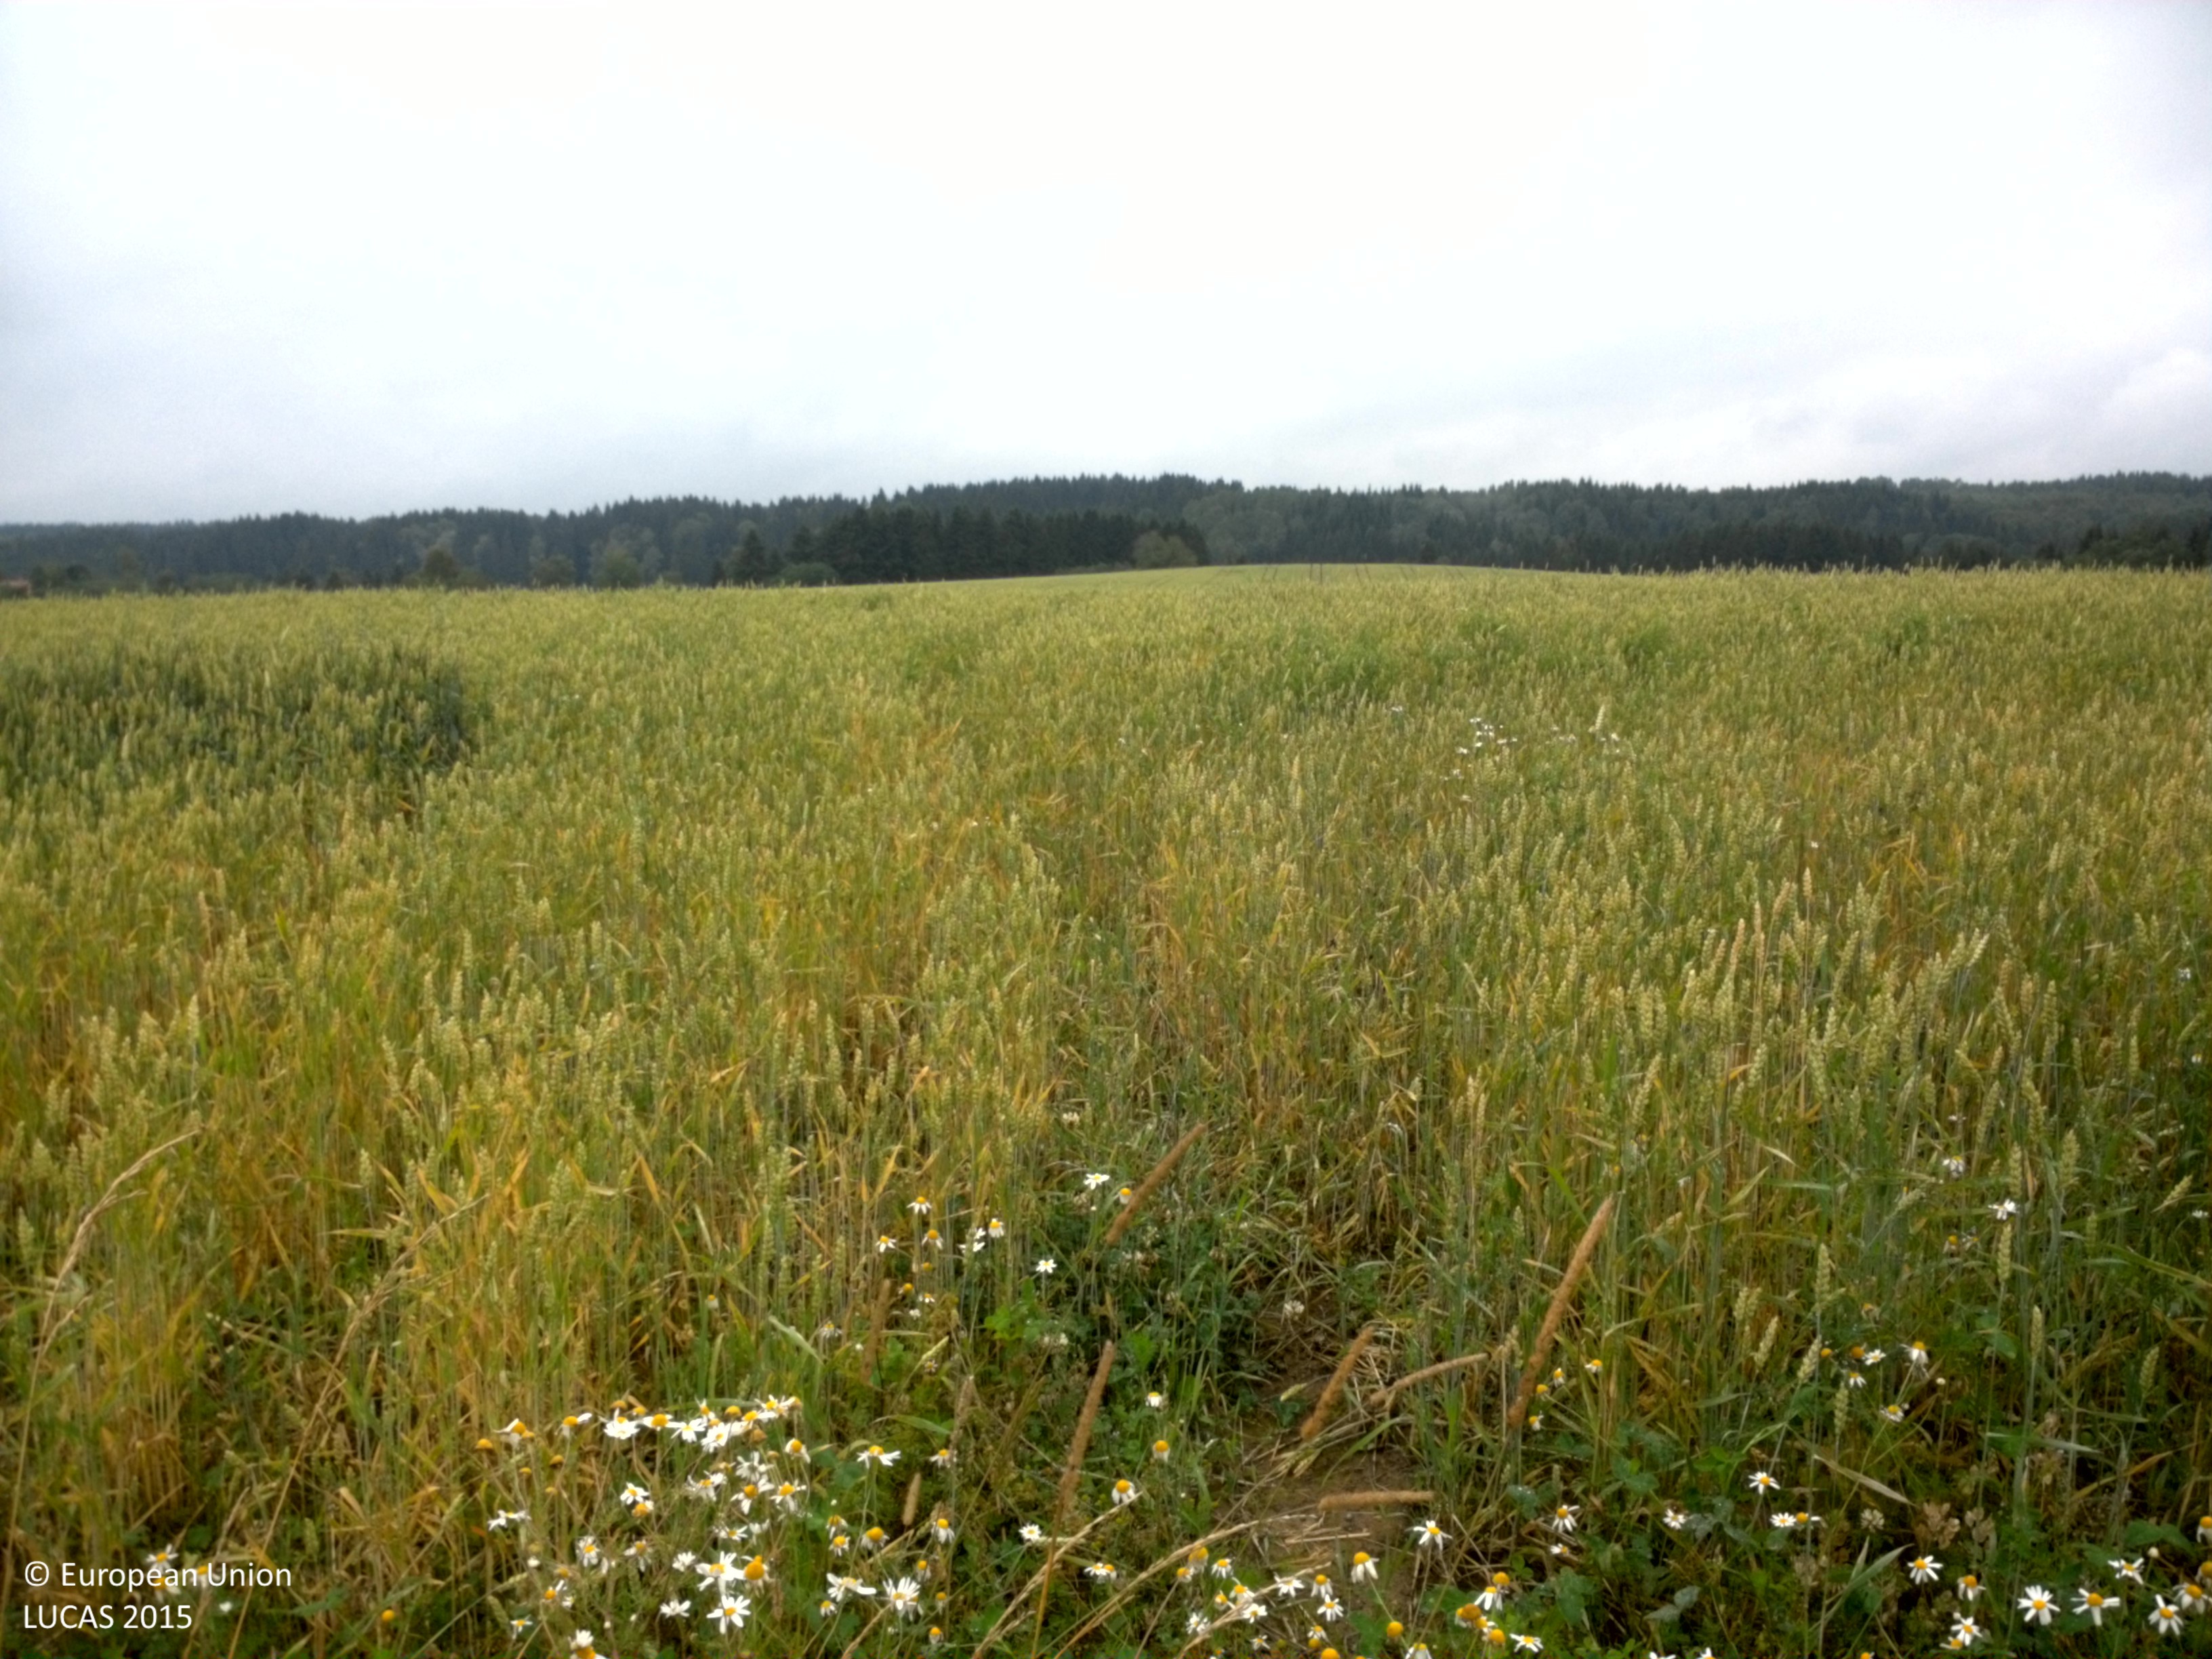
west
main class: Cropland
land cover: Common wheat
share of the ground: > 75 %
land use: Agriculture (excluding fallow land and kitchen gardens)
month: August
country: SE
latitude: 59.4945
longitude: 13.2596
